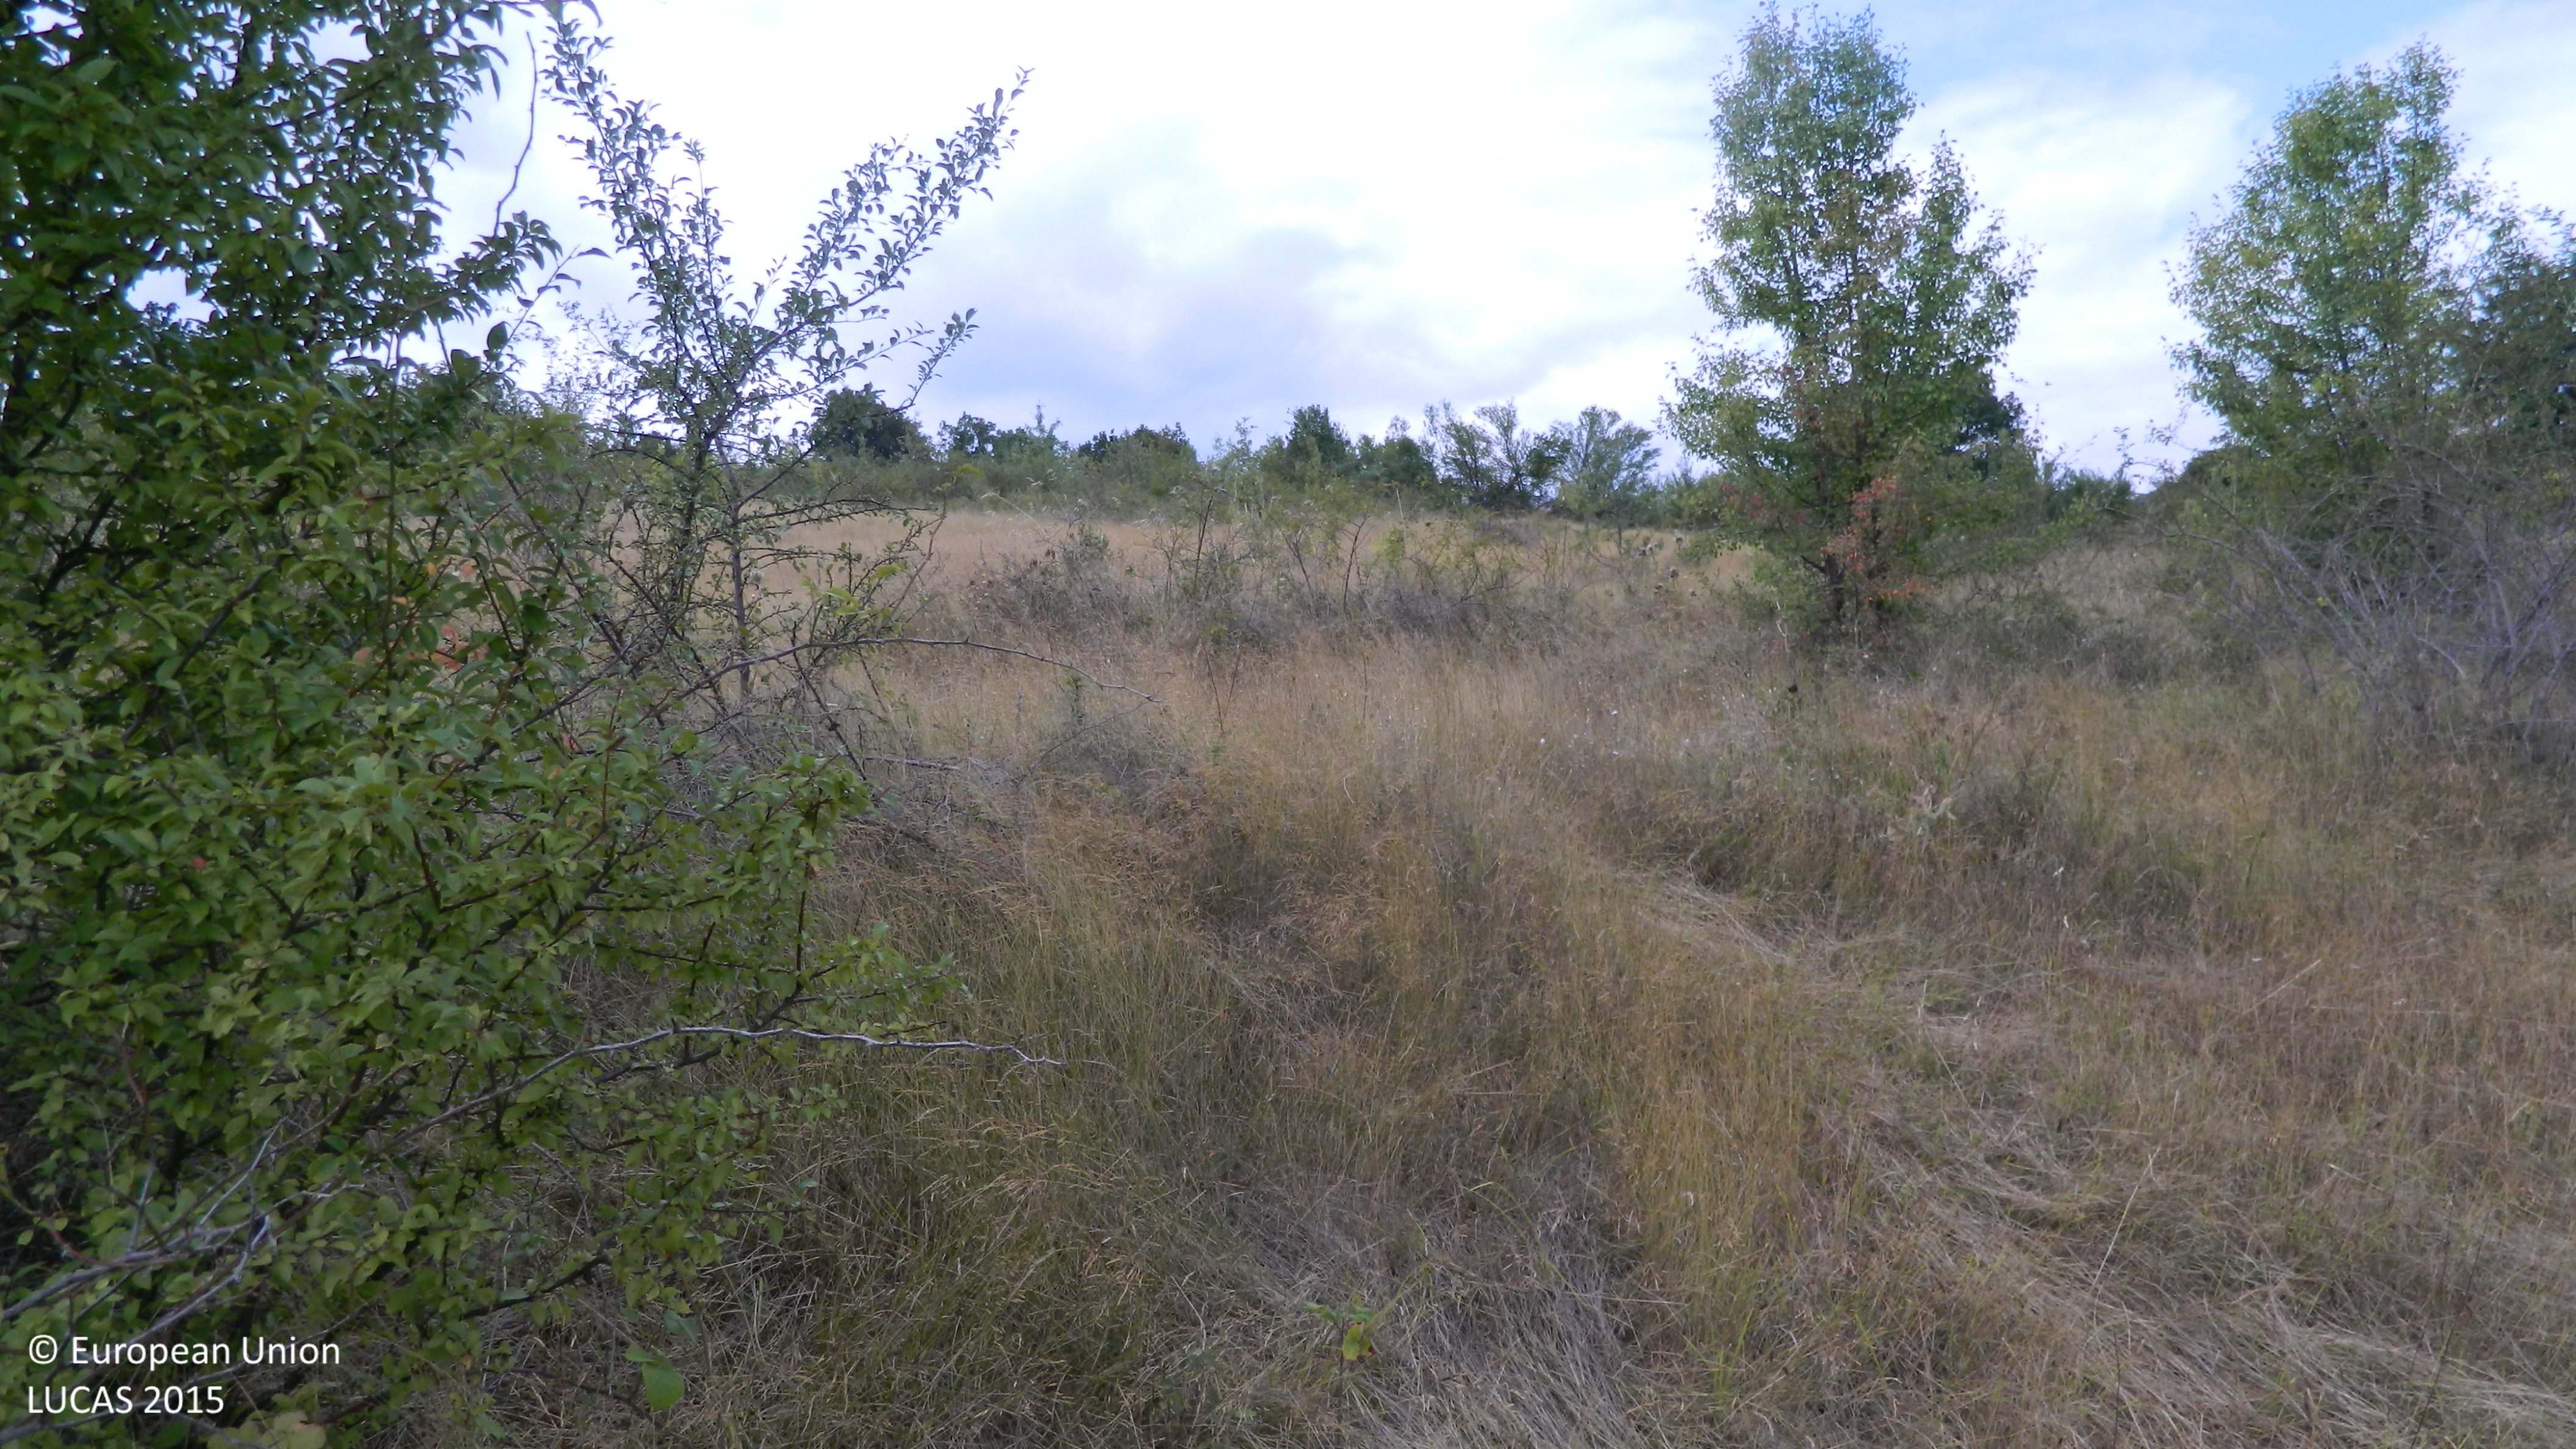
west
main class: Grassland
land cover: Grassland with sparse tree/shrub cover
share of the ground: > 75 %
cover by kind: herbaceous plants 85 %, shrubs 10 %, broadleaved forest trees 5 %
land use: Agriculture (excluding fallow land and kitchen gardens)
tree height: < 5 m
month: August
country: BG
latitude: 41.7095
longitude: 25.8474
